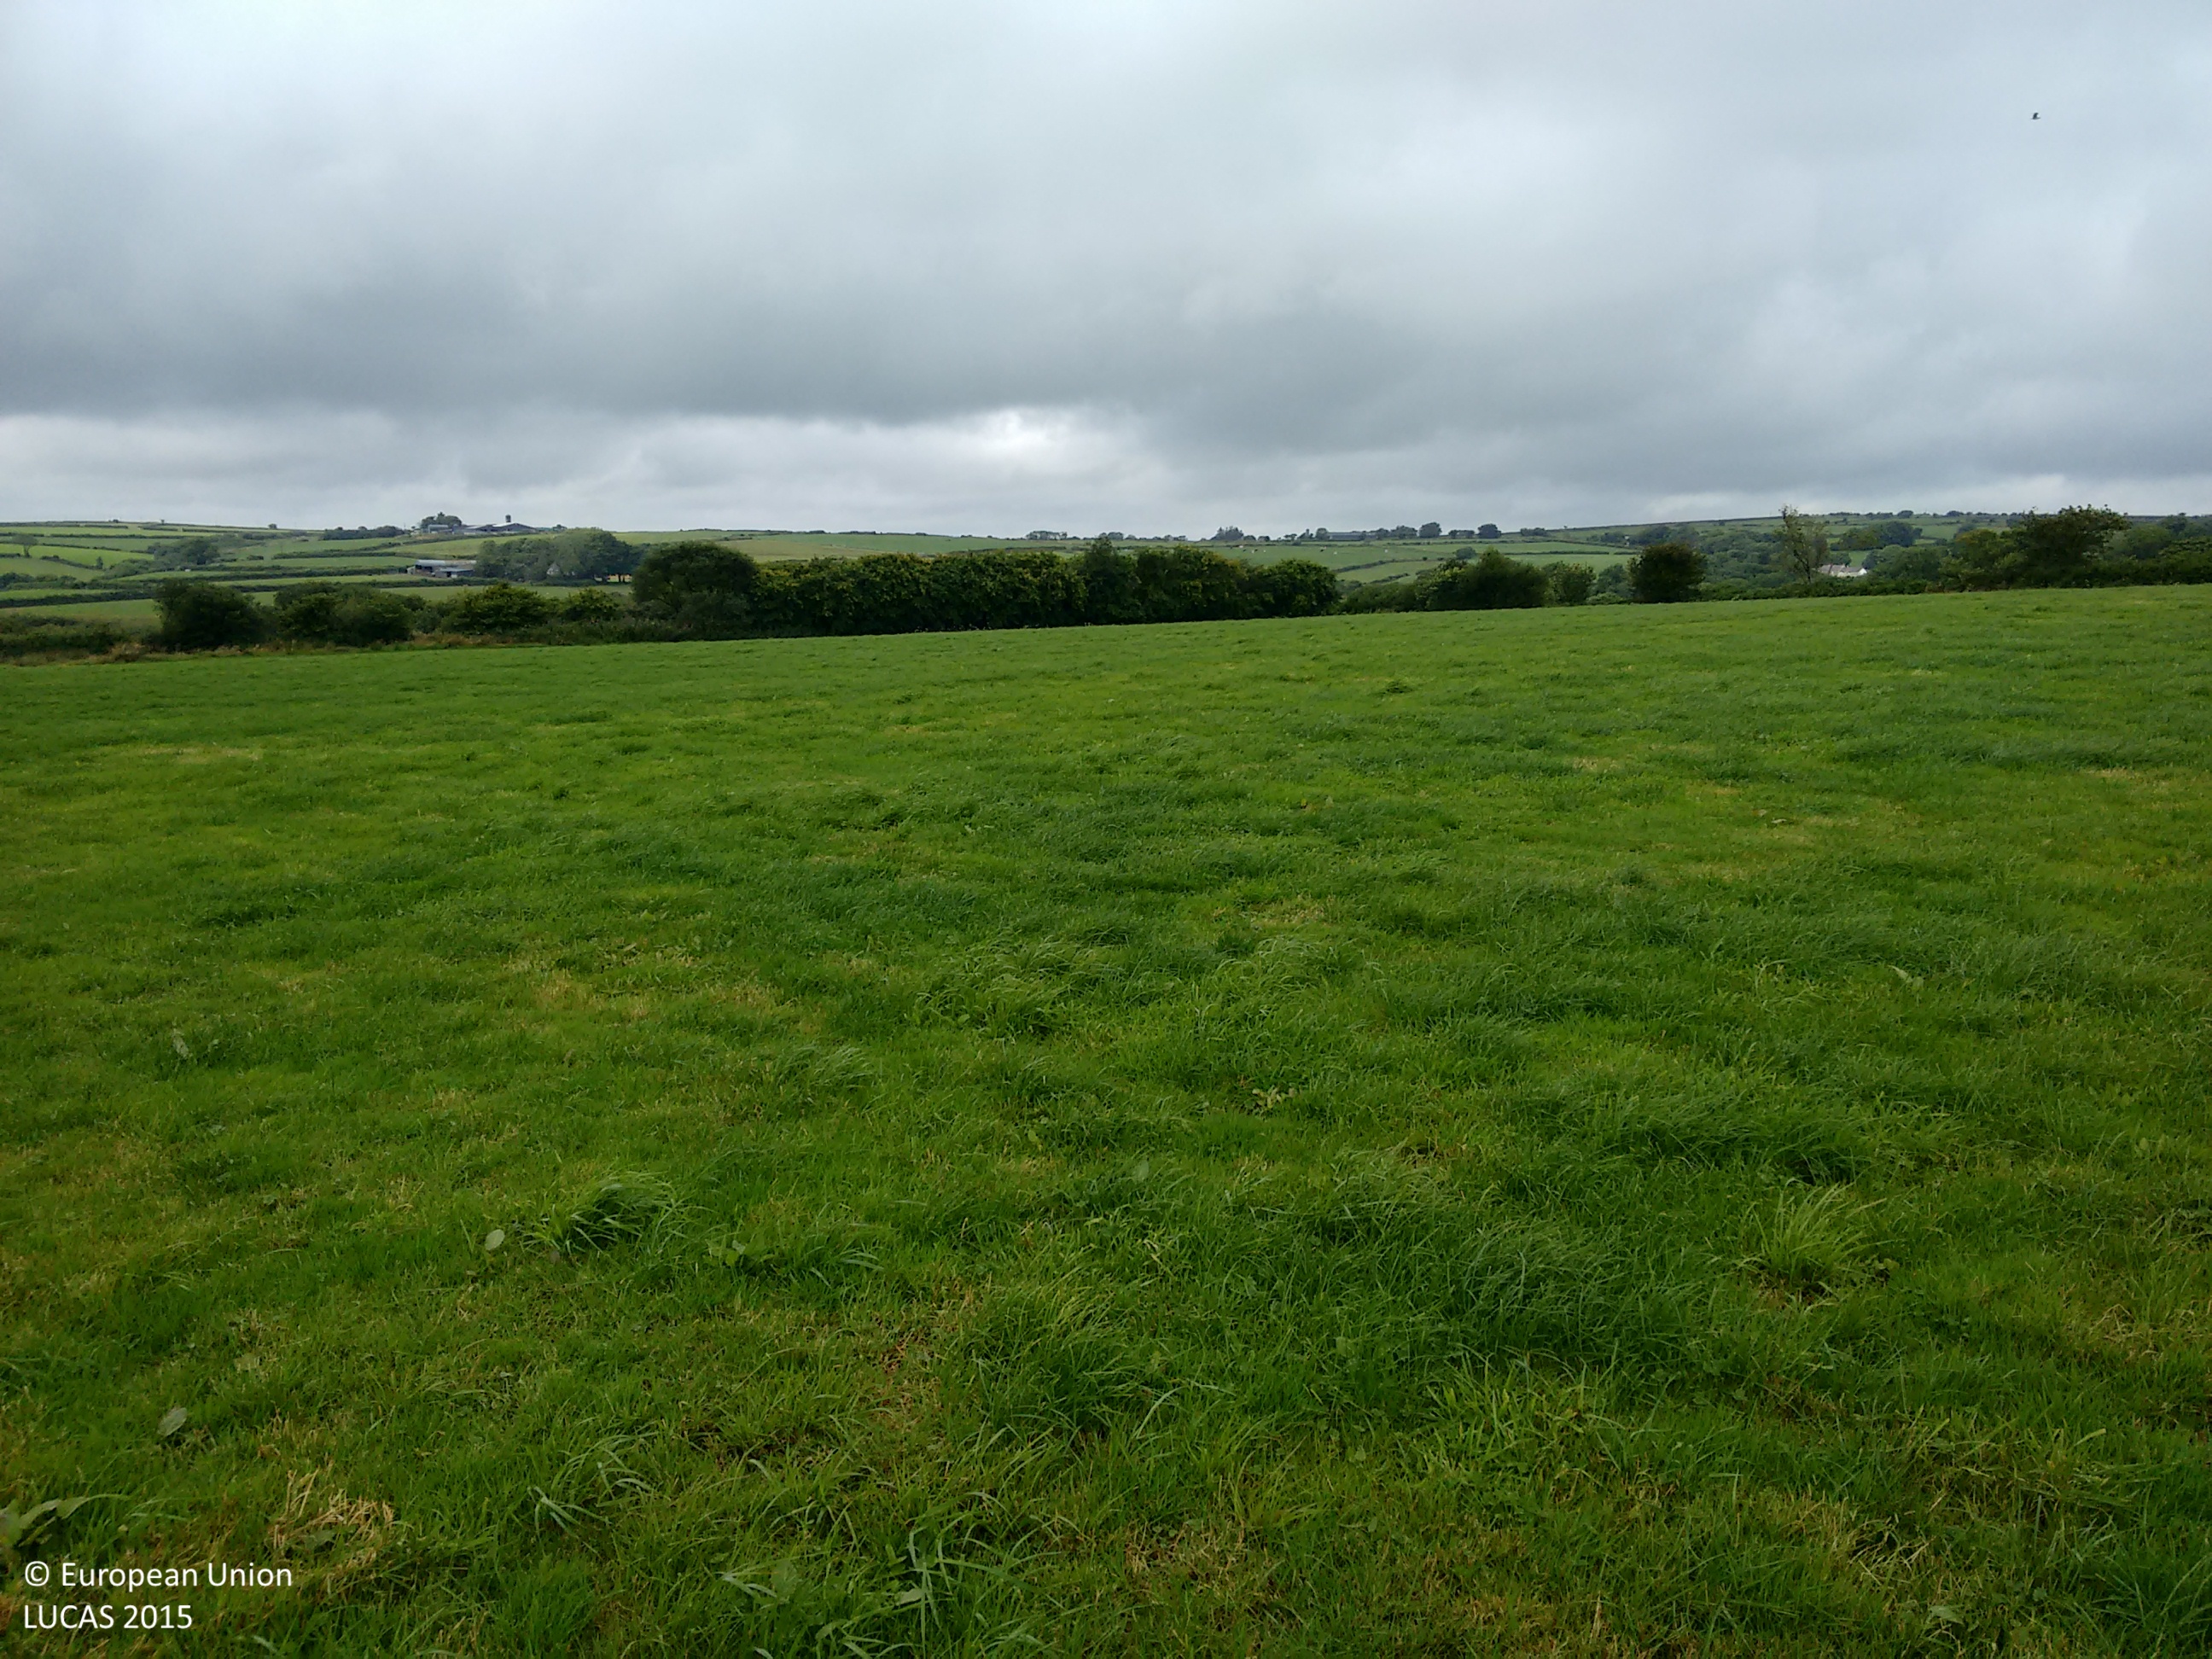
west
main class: Grassland
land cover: Grassland without tree/shrub cover
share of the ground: > 75 %
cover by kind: herbaceous plants 100 %
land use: Agriculture (excluding fallow land and kitchen gardens)
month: August
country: GB
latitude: 51.9459
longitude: -4.4340
